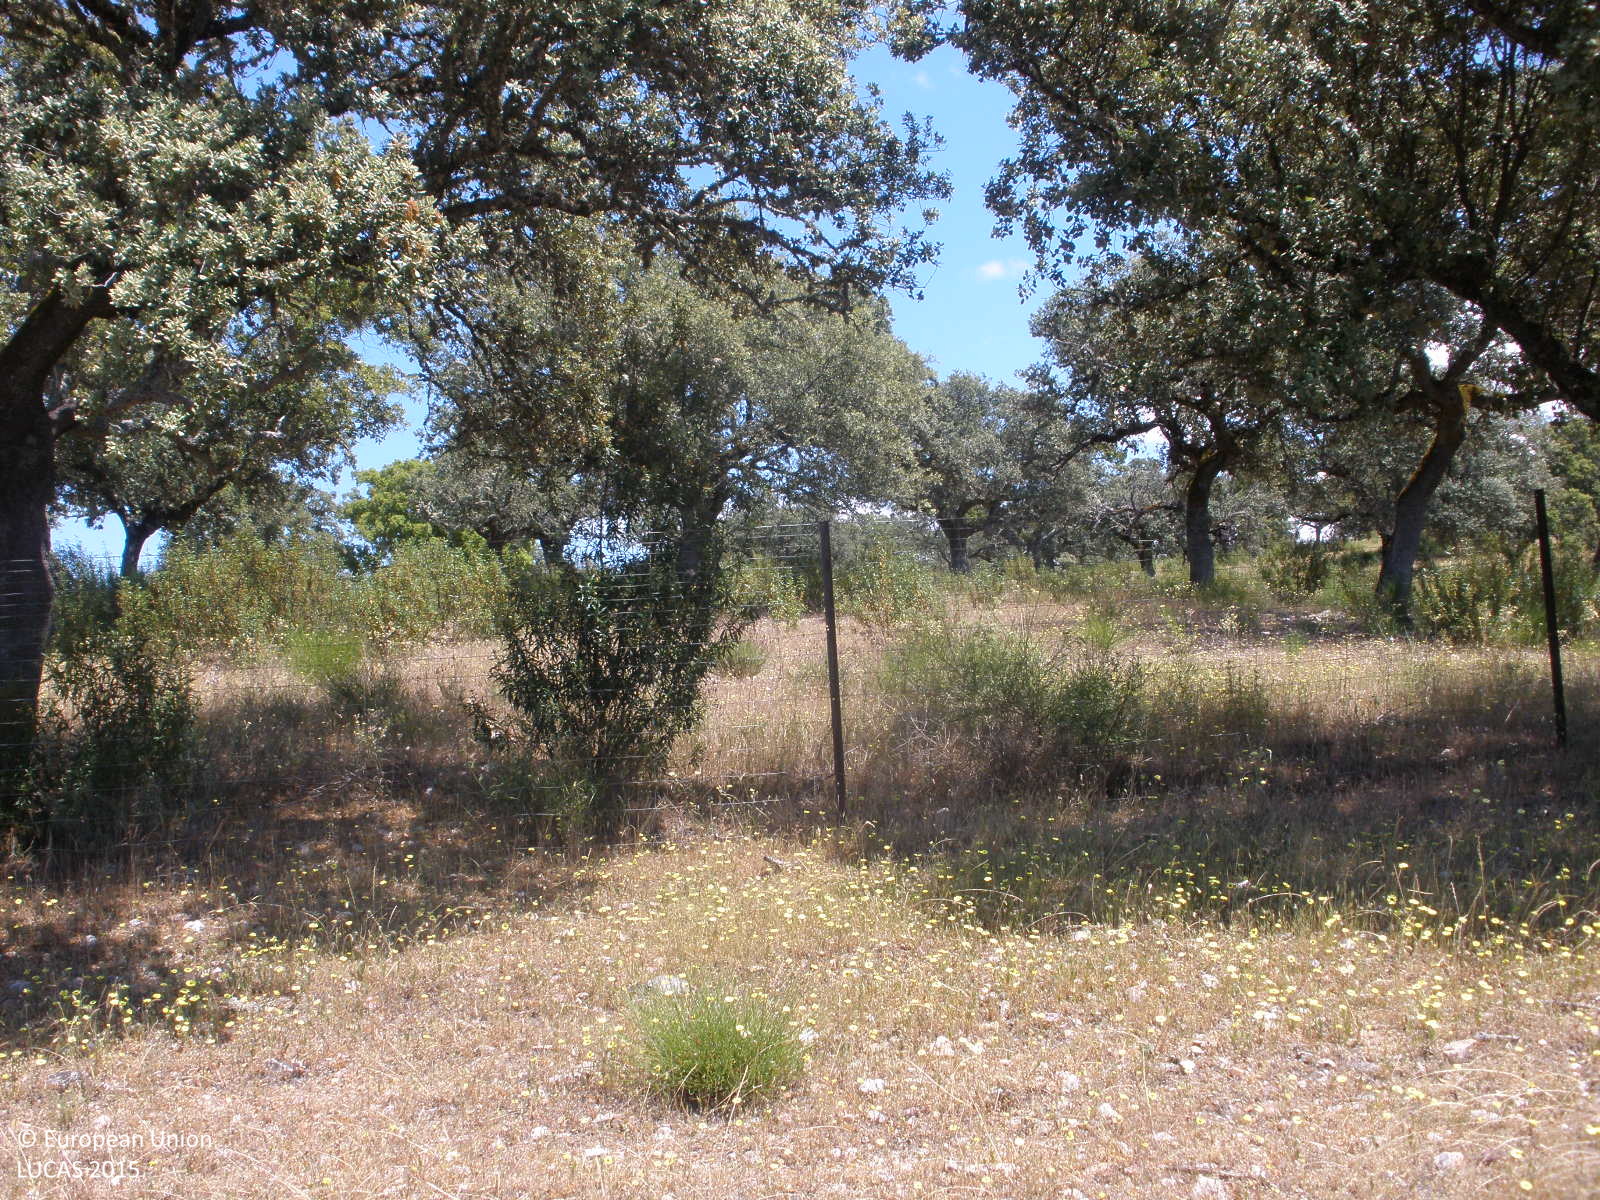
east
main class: Woodland
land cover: Broadleaved woodland
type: broadleaved evergreen forest
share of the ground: 10 - 25 %
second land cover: Grassland without tree/shrub cover
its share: > 75 %
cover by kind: herbaceous plants 70 %, broadleaved forest trees 10 %, shrubs 10 %, consolidated bare surface 10 %
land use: Forestry
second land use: Agriculture (excluding fallow land and kitchen gardens)
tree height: > 5 m
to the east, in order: Broadleaved woodland; Grassland without tree/shrub cover; Fences; Broadleaved woodland
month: May
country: ES
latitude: 40.2391
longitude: -6.0721
